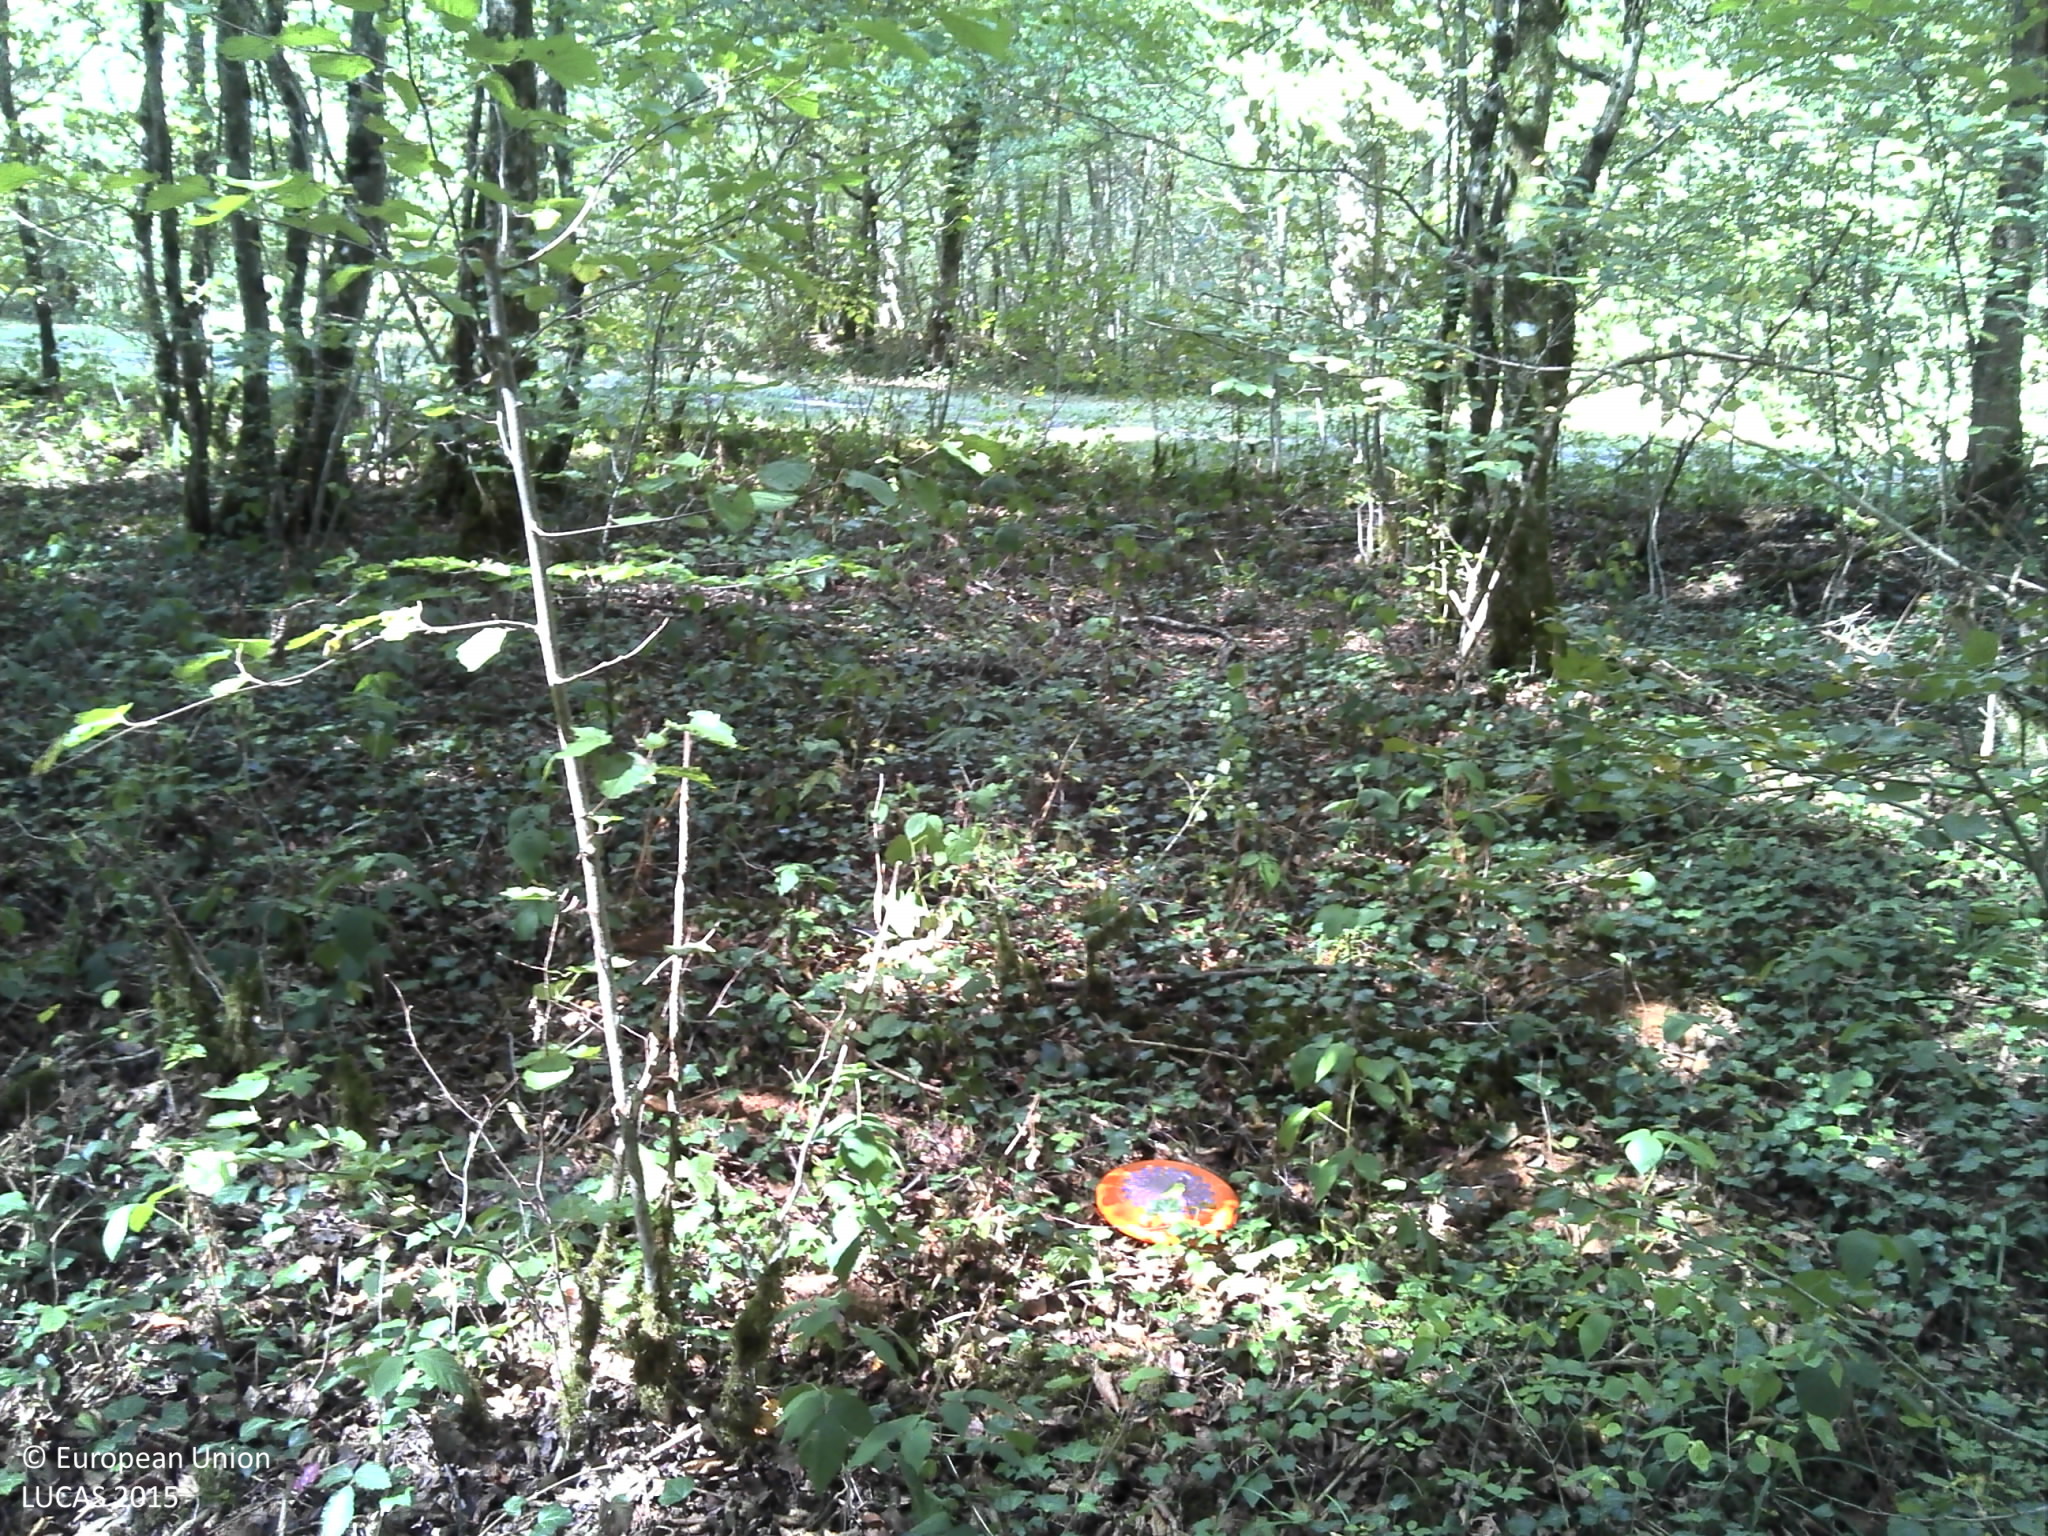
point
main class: Woodland
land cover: Broadleaved woodland
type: mesophytic deciduous forest
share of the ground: > 75 %
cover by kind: broadleaved forest trees 85 %, herbaceous plants 10 %, lichens and mosses 5 %
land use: Forestry
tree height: > 5 m
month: July
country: FR
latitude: 48.0722
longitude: 5.3693
